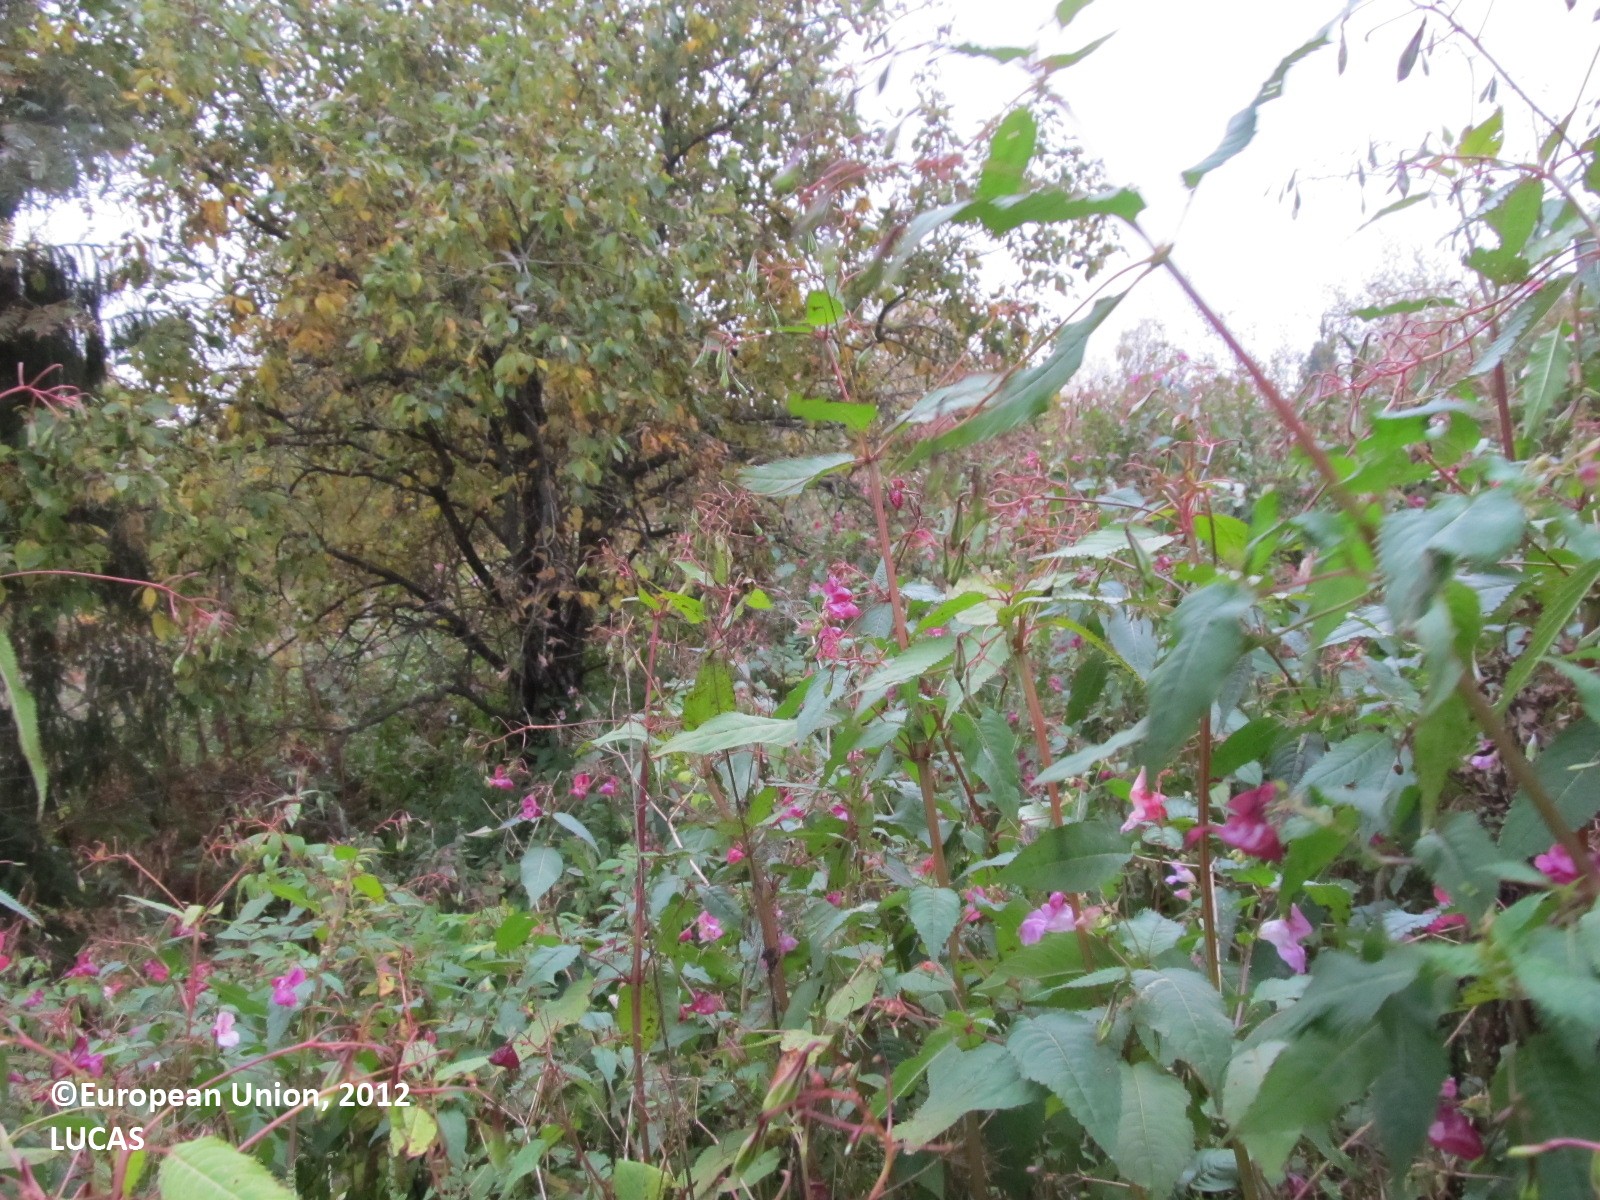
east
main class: Shrubland
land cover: Shrubland with sparse tree cover
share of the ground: > 75 %
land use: Semi-natural and natural areas not in use
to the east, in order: Shrubland with sparse tree cover; Grassland without tree/shrub cover; Broadleaved woodland; Electric lines; Grassland without tree/shrub cover; Abandoned hedges; Tracks; Abandoned hedges; Ditches and canals; Grassland without tree/shrub cover
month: September
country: FI
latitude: 62.2600
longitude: 28.1197
